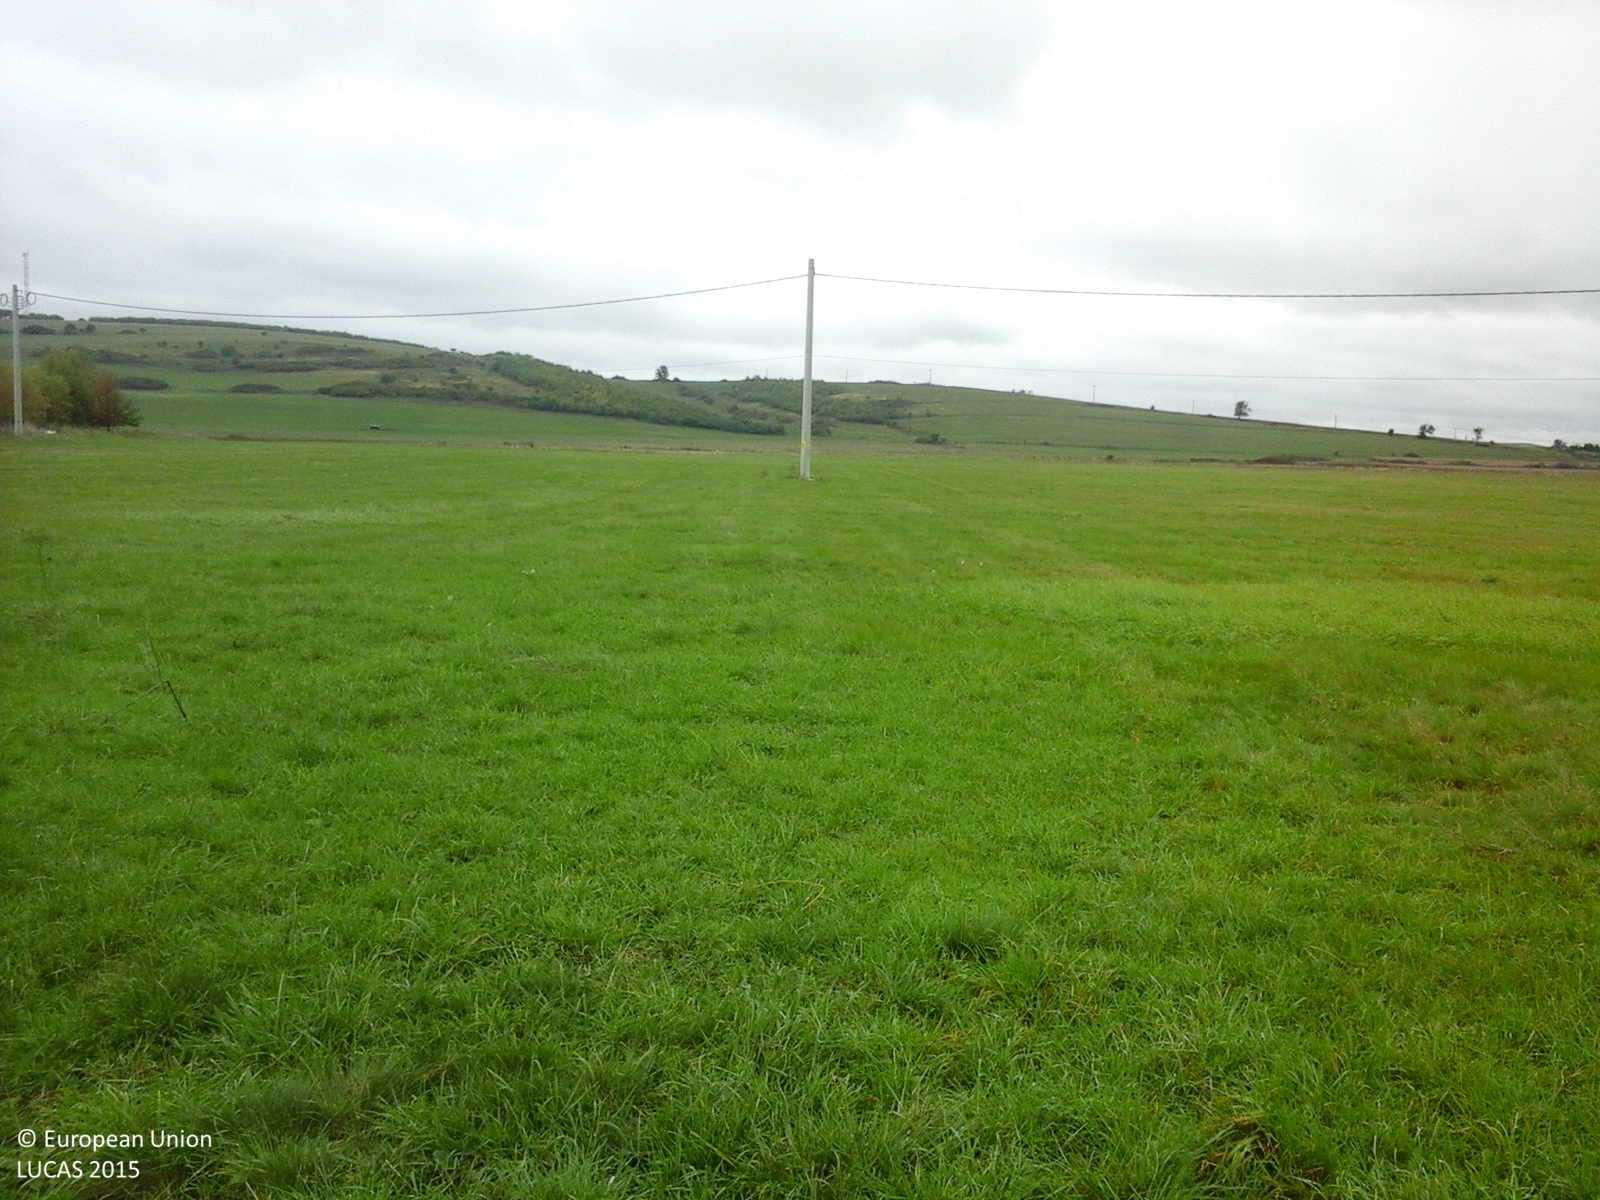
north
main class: Cropland
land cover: Maize
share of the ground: > 75 %
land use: Agriculture (excluding fallow land and kitchen gardens)
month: October
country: RO
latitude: 45.8293
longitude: 24.1188
